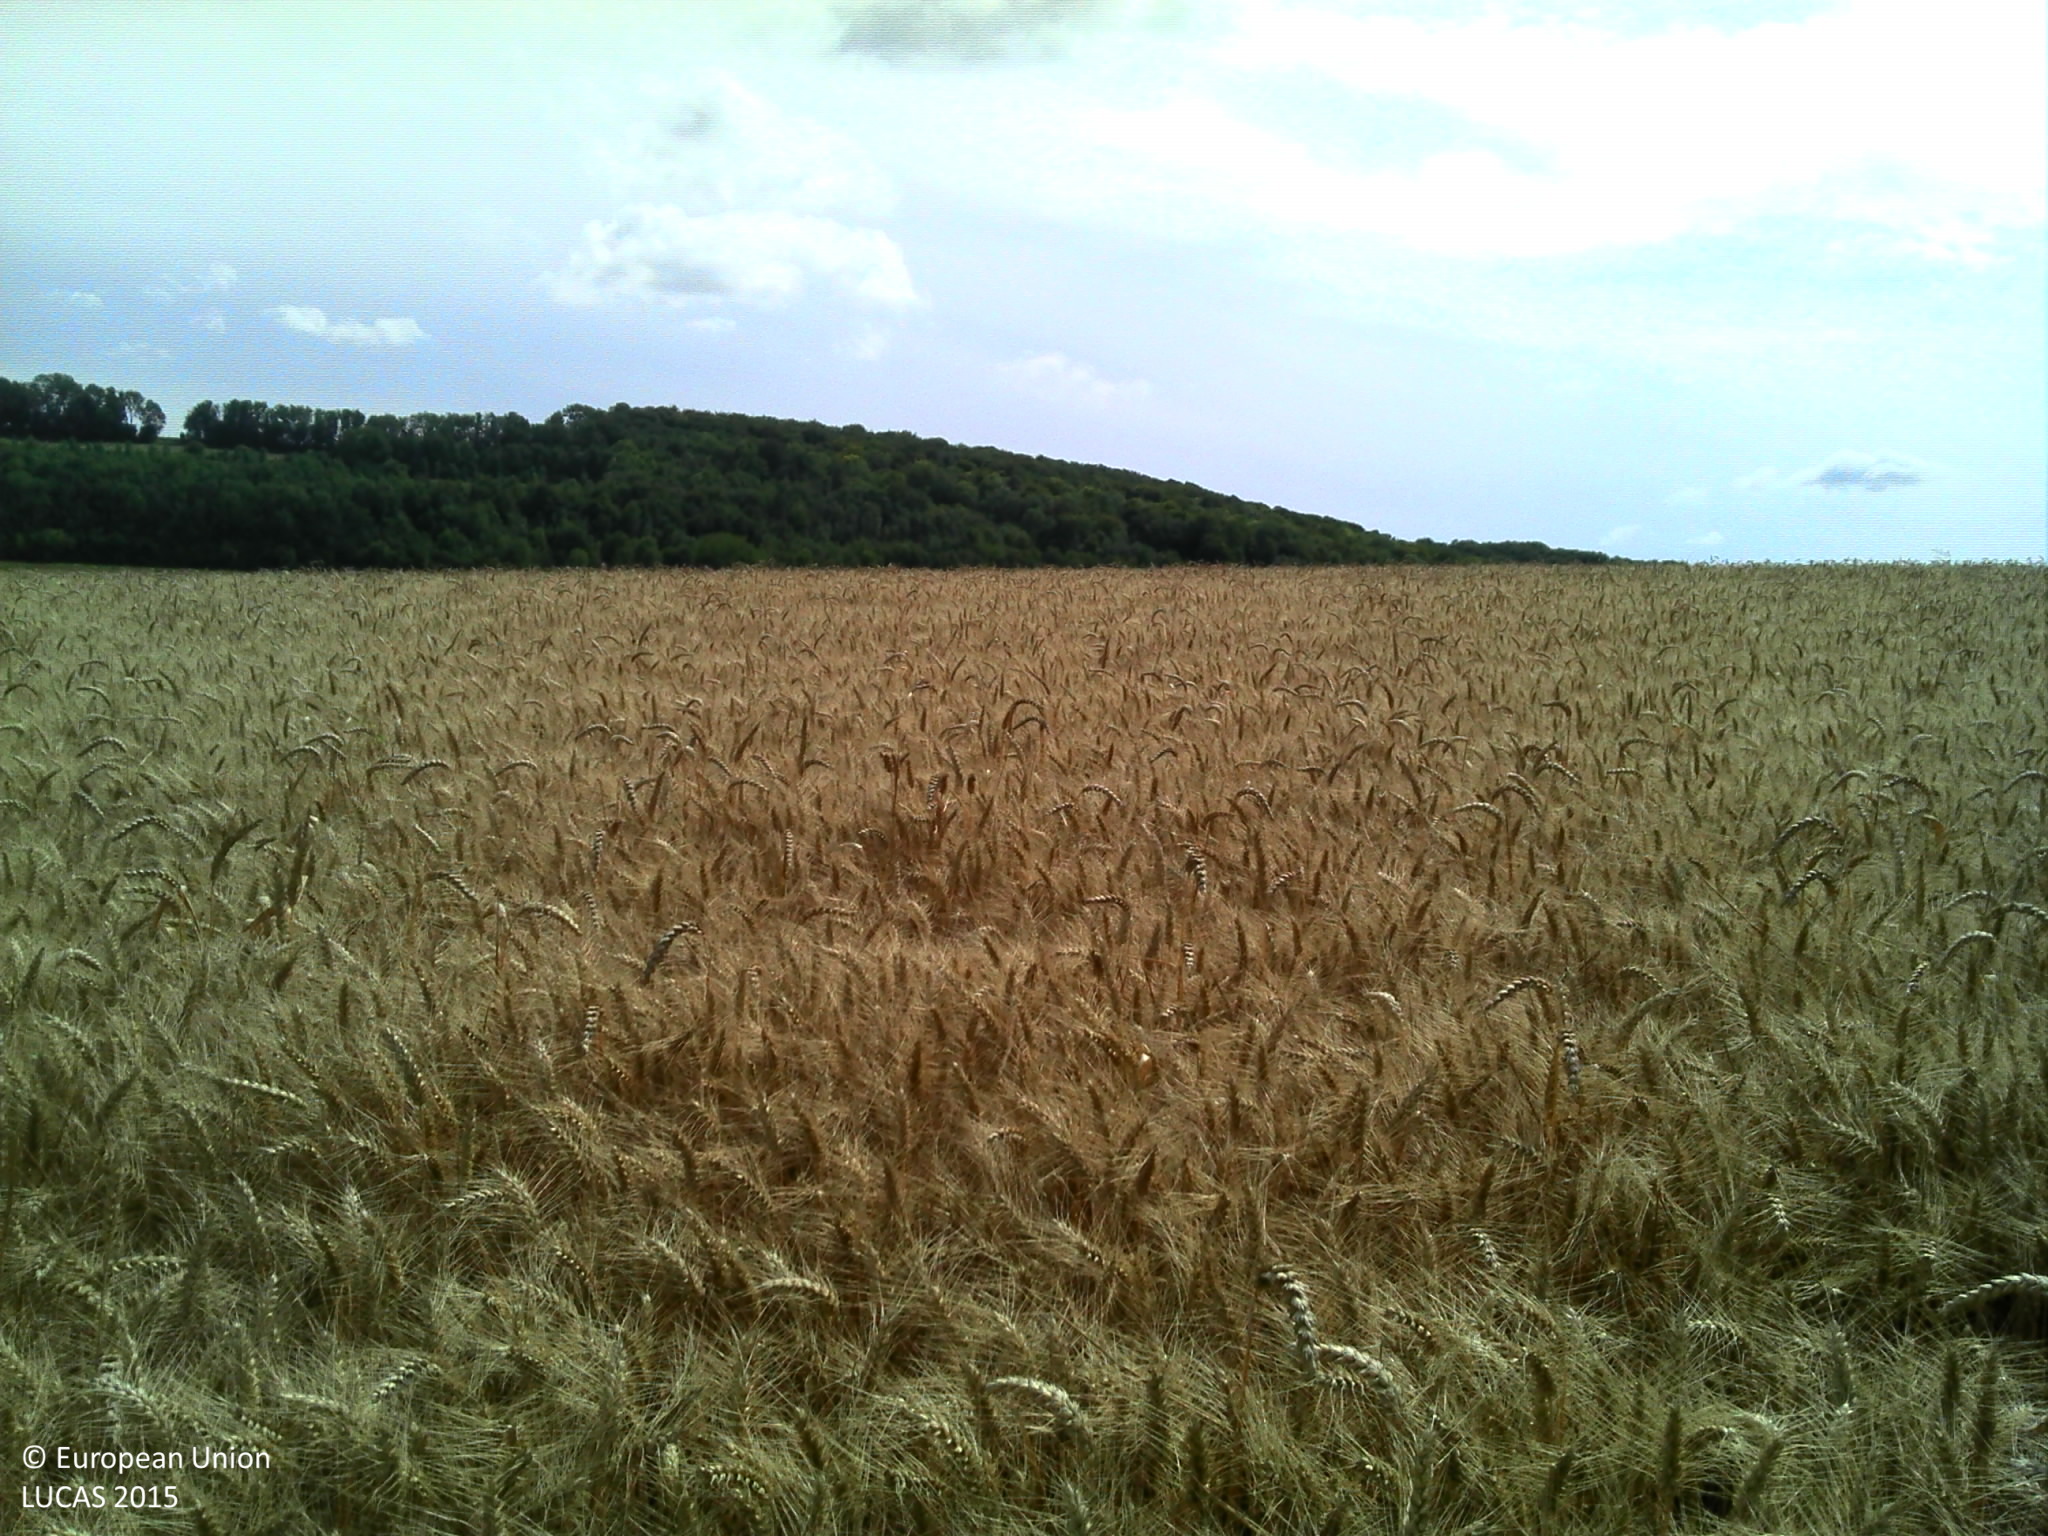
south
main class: Cropland
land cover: Common wheat
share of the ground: > 75 %
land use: Agriculture (excluding fallow land and kitchen gardens)
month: July
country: FR
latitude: 50.1529
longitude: 2.2182
